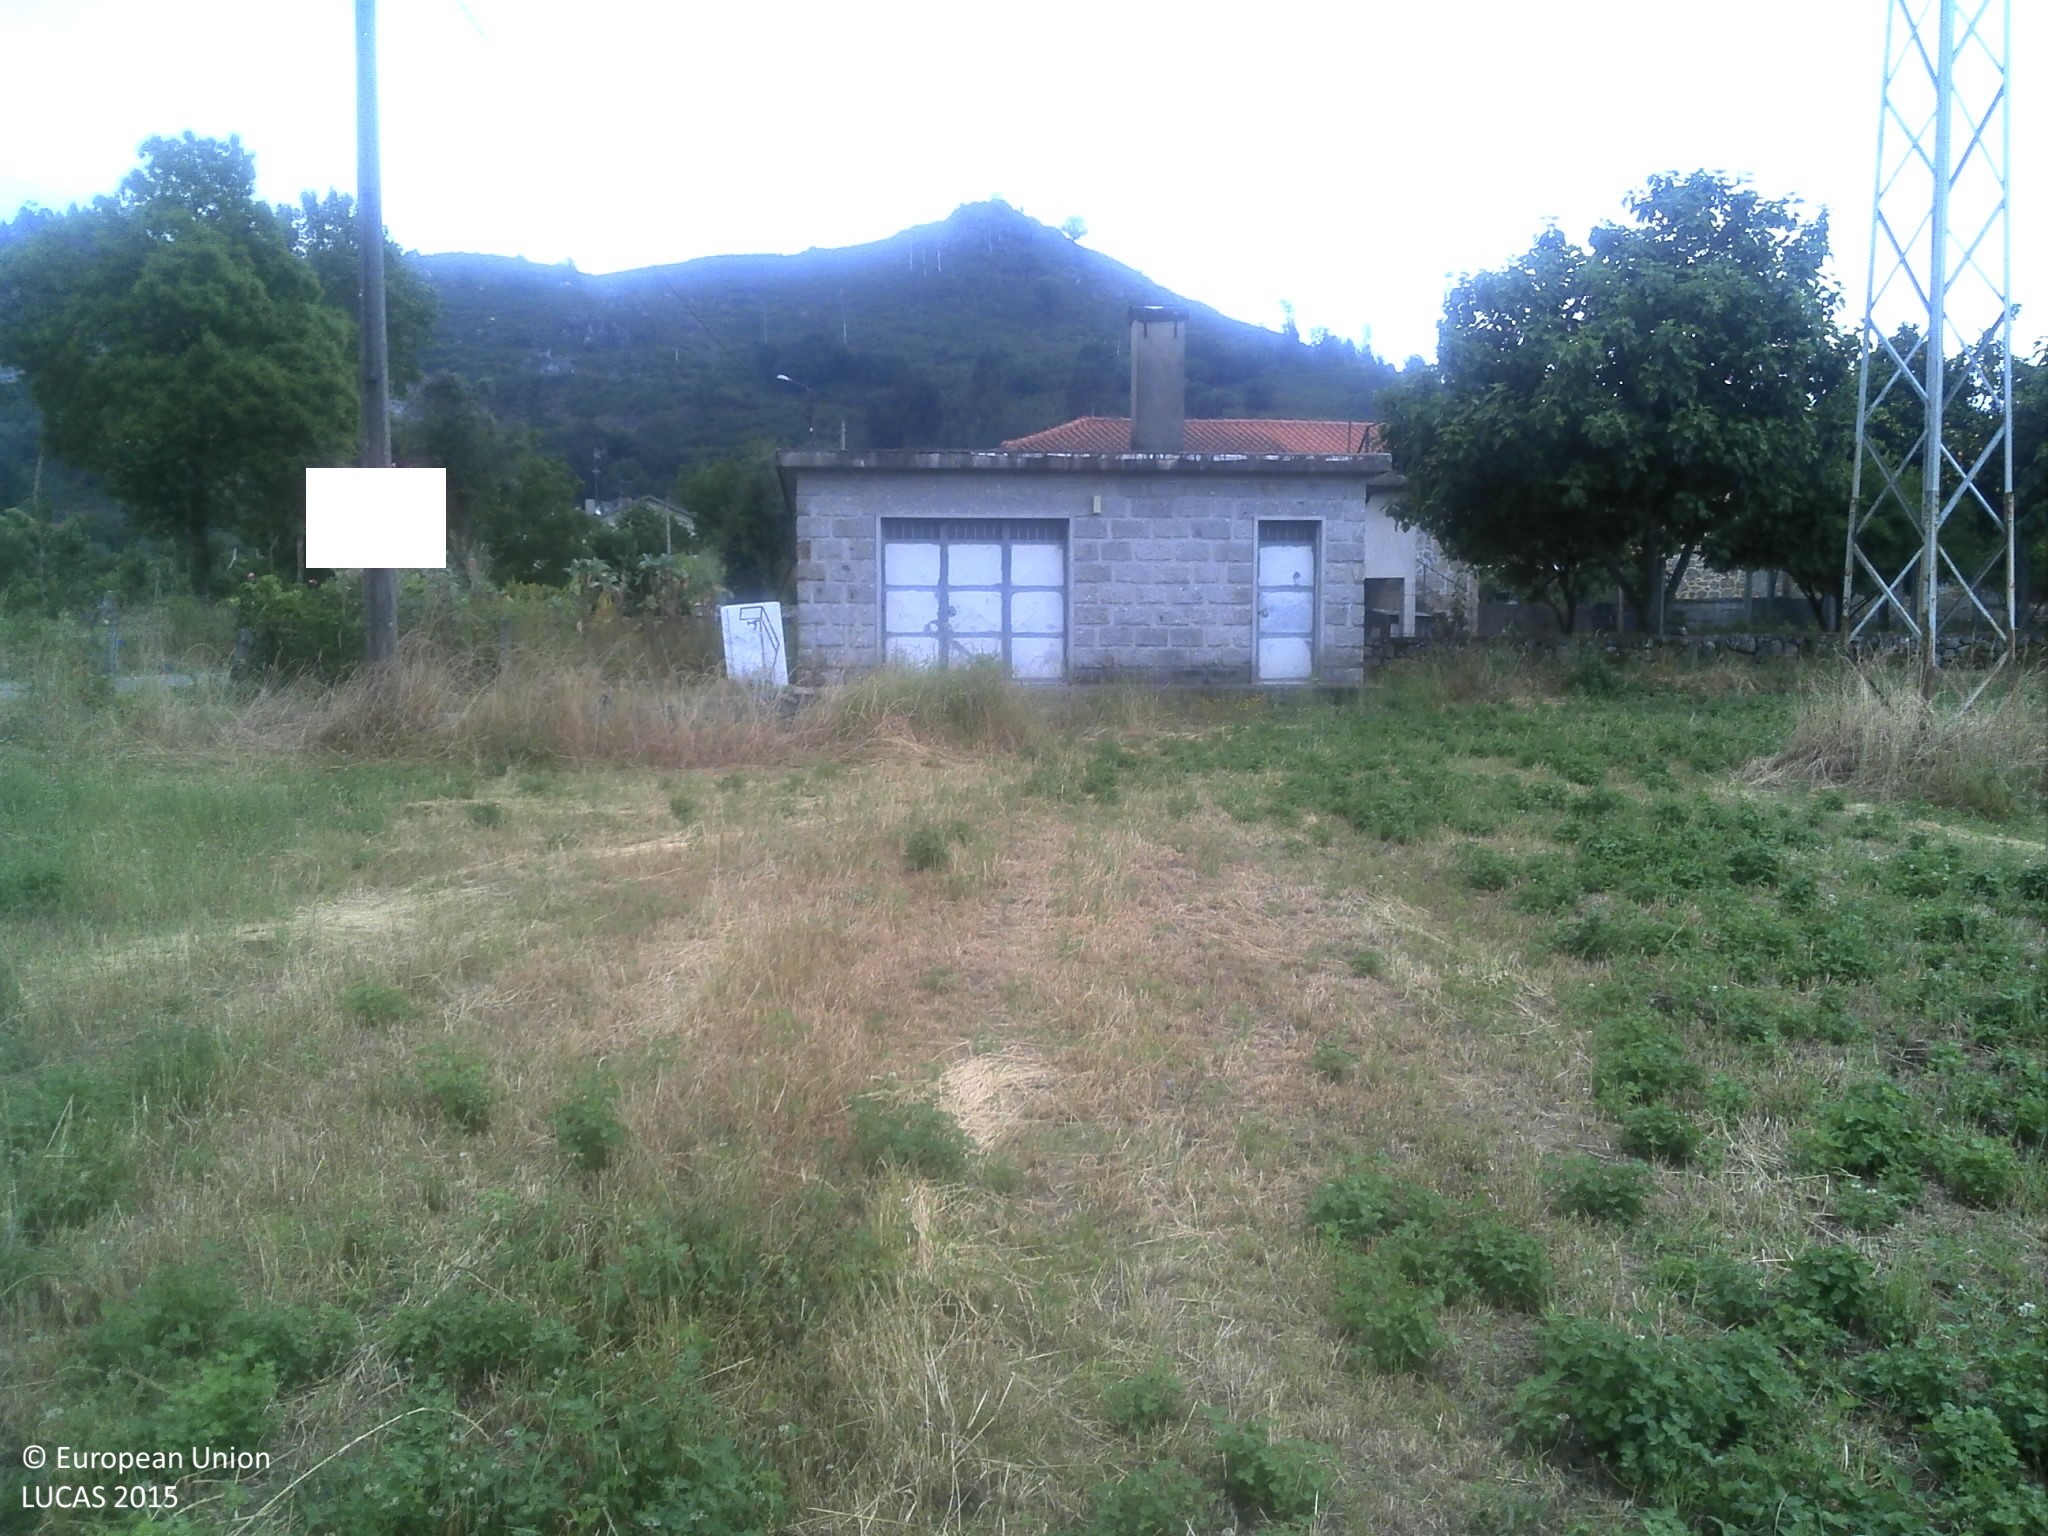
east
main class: Grassland
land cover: Grassland without tree/shrub cover
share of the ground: > 75 %
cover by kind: herbaceous plants 75 %, unconsolidated bare surface 25 %
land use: Semi-natural and natural areas not in use
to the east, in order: Grassland without tree/shrub cover; Electric lines; Grassland without tree/shrub cover; Artificial constructions in urban areas; Other fruit trees and berries; Artificial constructions in urban areas; Spontaneously vegetated surfaces; Artificial constructions in urban areas; Vineyards; Temporary grasslands; Vineyards; Dry stone walls; Paved roads, cycling and walking lanes; Grass margins; Dry stone walls; Abandoned hedges; Grassland without tree/shrub cover; Other fresh vegetables
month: June
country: PT
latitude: 41.6891
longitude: -8.4055
